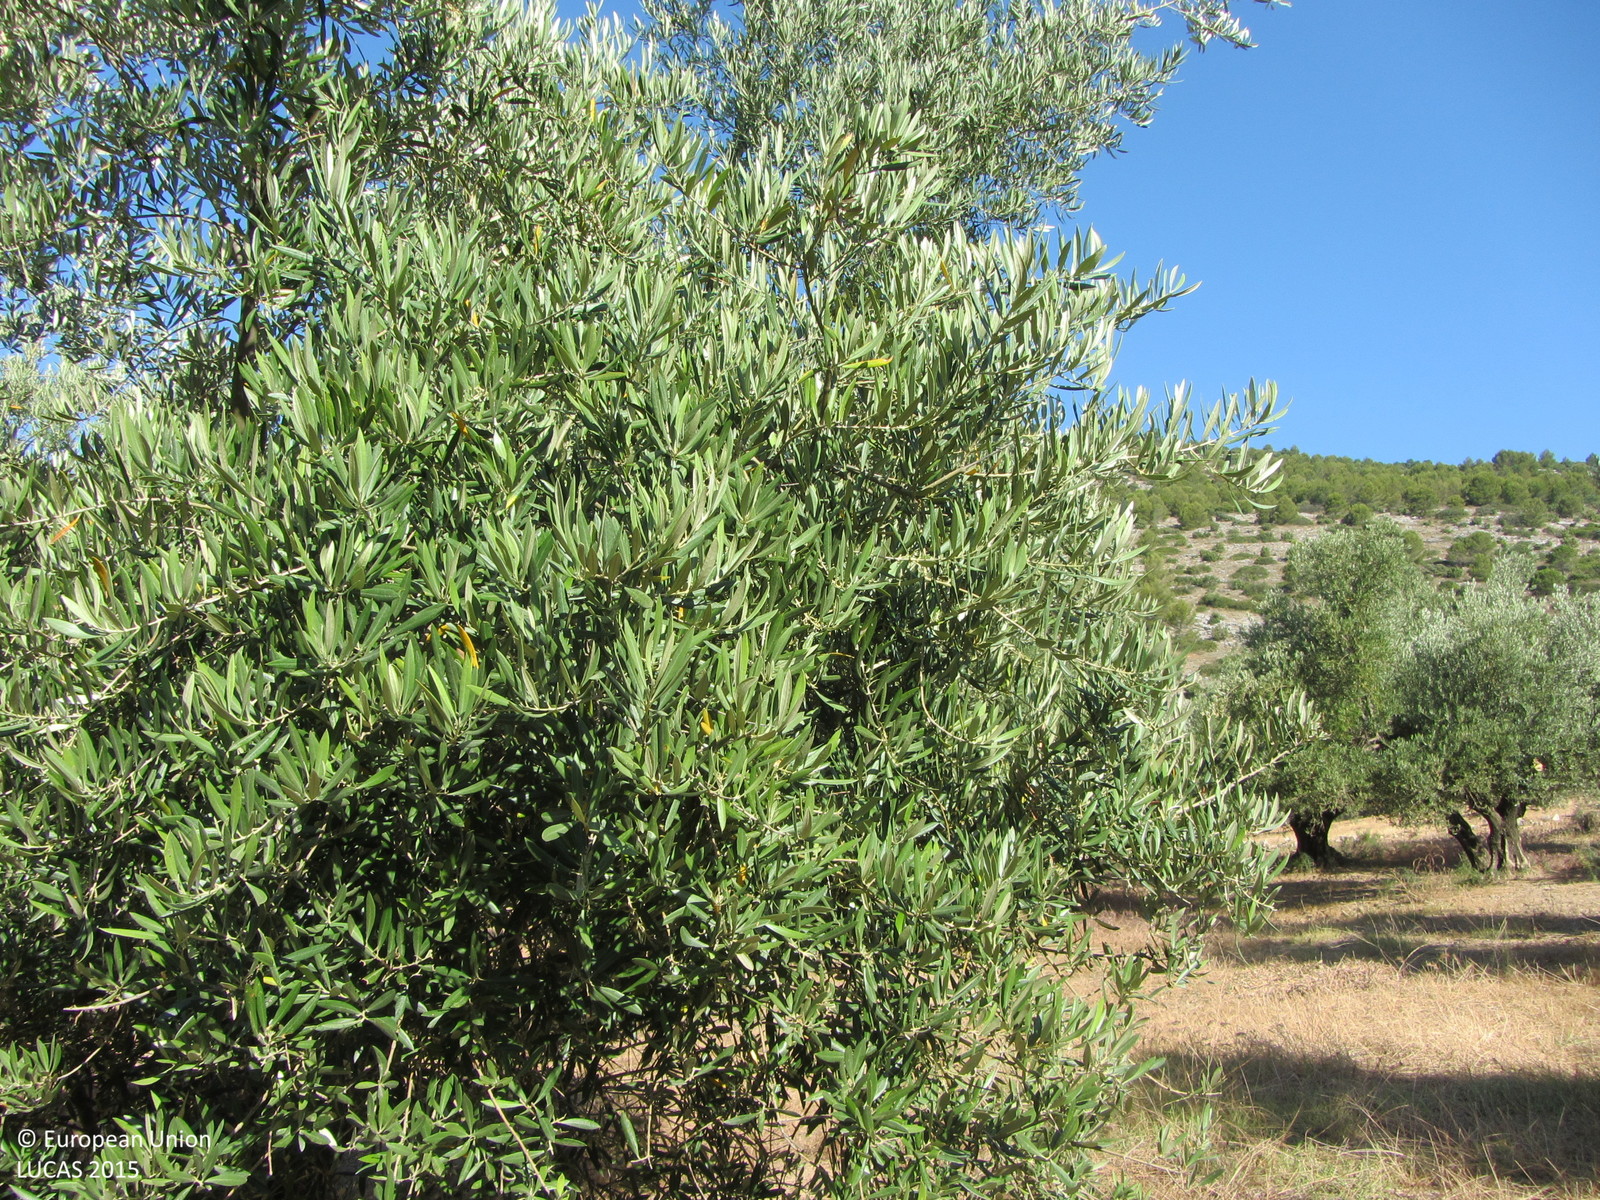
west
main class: Cropland
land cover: Olive groves
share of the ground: 50 - 75 %
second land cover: Other bare soil
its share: > 75 %
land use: Agriculture (excluding fallow land and kitchen gardens)
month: June
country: ES
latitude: 38.1927
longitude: -2.8429
